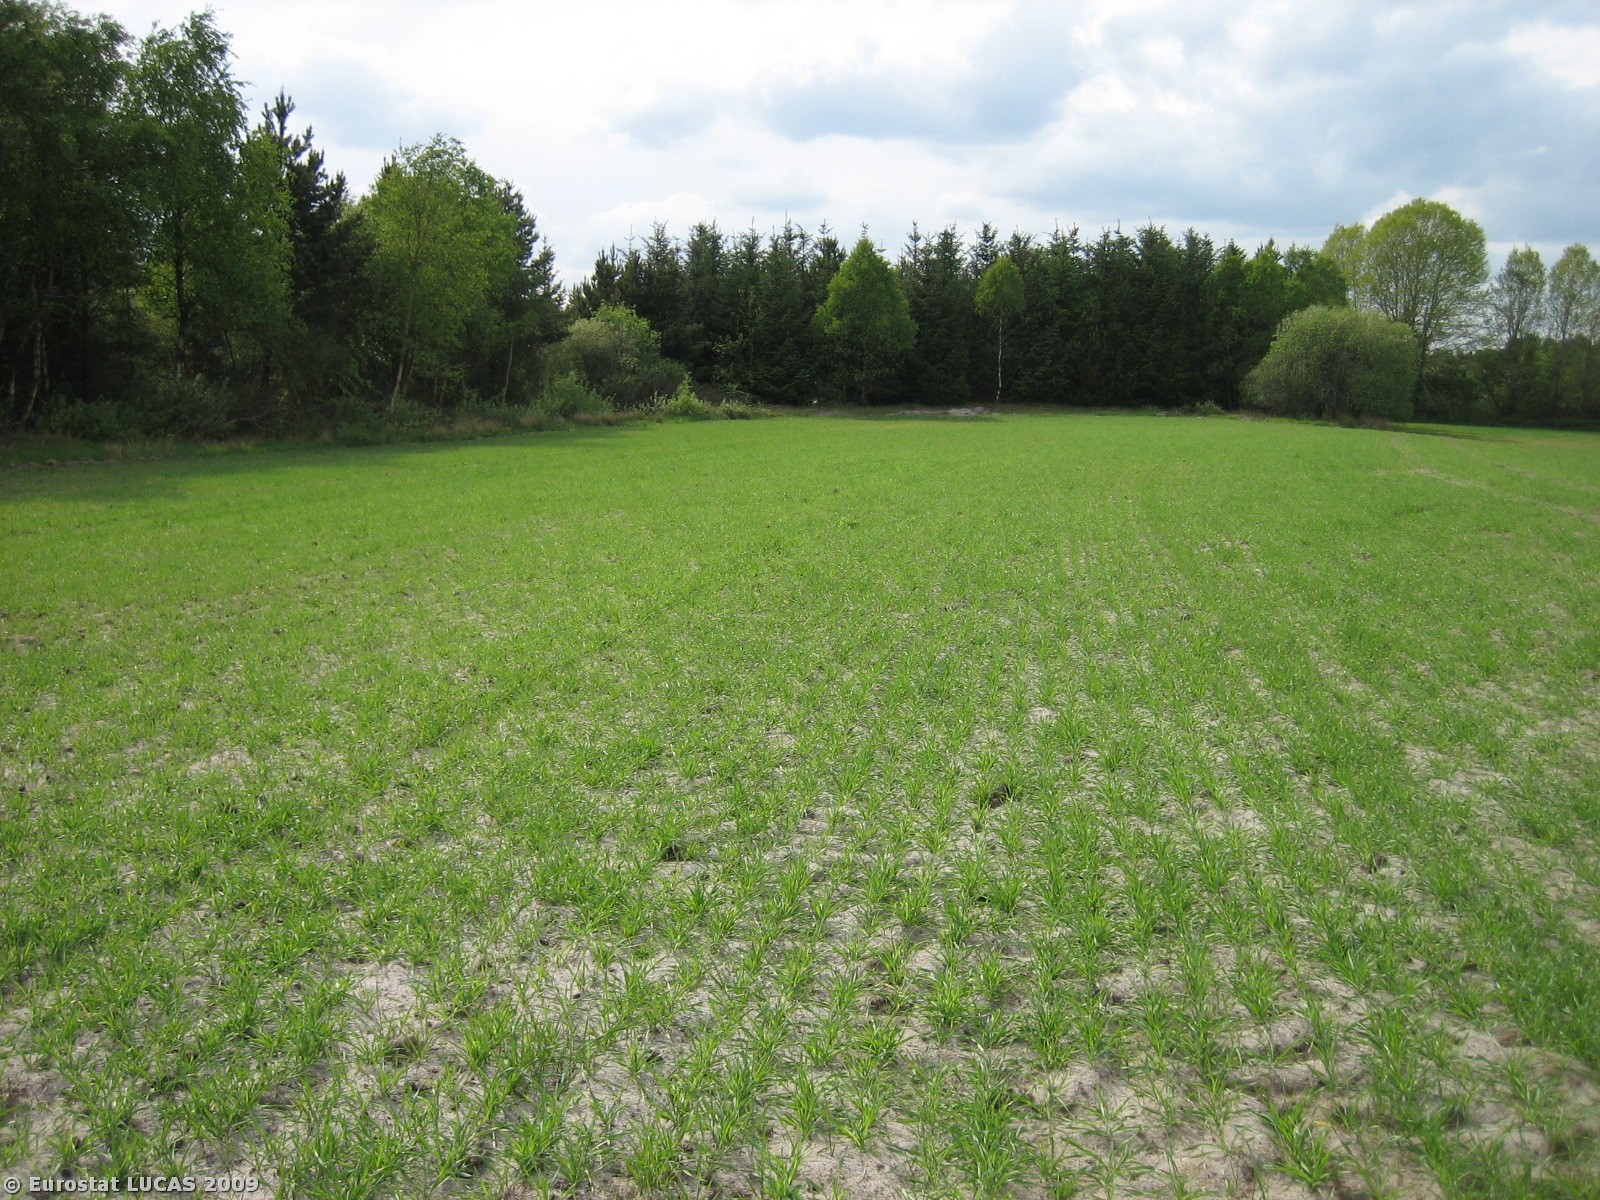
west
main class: Cropland
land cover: Barley
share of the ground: 25 - 50 %
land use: Agriculture (excluding fallow land and kitchen gardens)
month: May
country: DK
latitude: 56.2213
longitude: 9.2107
